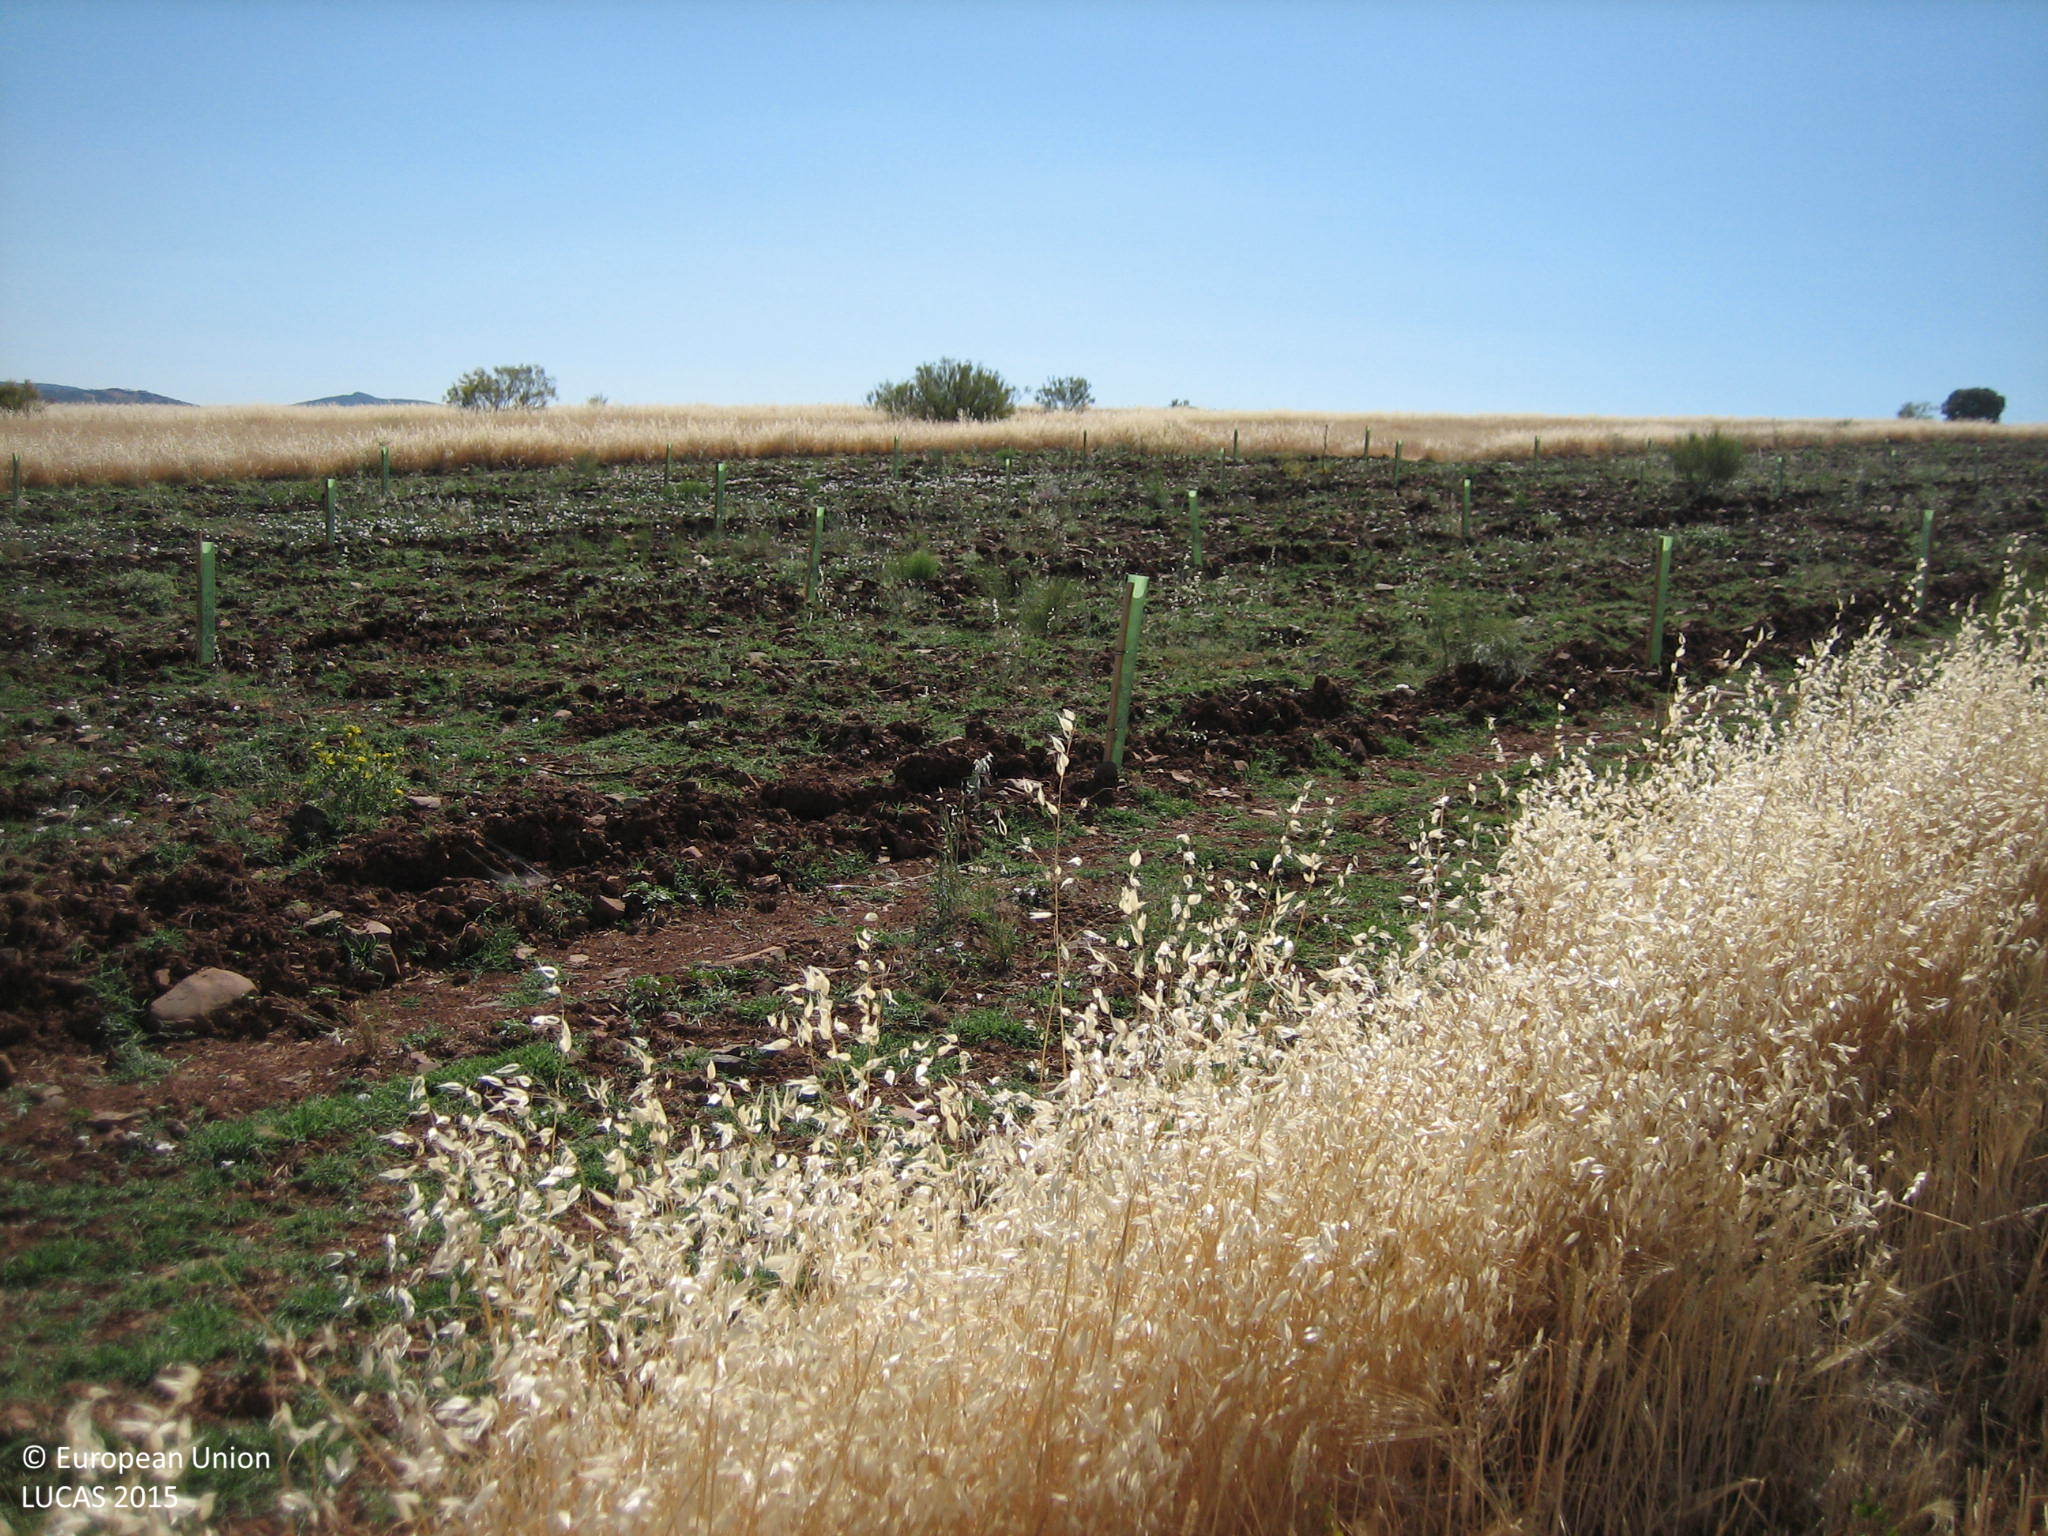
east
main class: Cropland
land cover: Common wheat
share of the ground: < 10 %
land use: Agriculture (excluding fallow land and kitchen gardens)
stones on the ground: < 10 %
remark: Harvested field
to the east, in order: Common wheat; Grass margins; Olive groves; Grass margins; Oats; Grass margins; Common wheat; Grass margins; Spontaneously vegetated surfaces; Grass margins; Common wheat; Grass margins; Olive groves
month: June
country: ES
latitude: 38.6315
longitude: -4.0194
